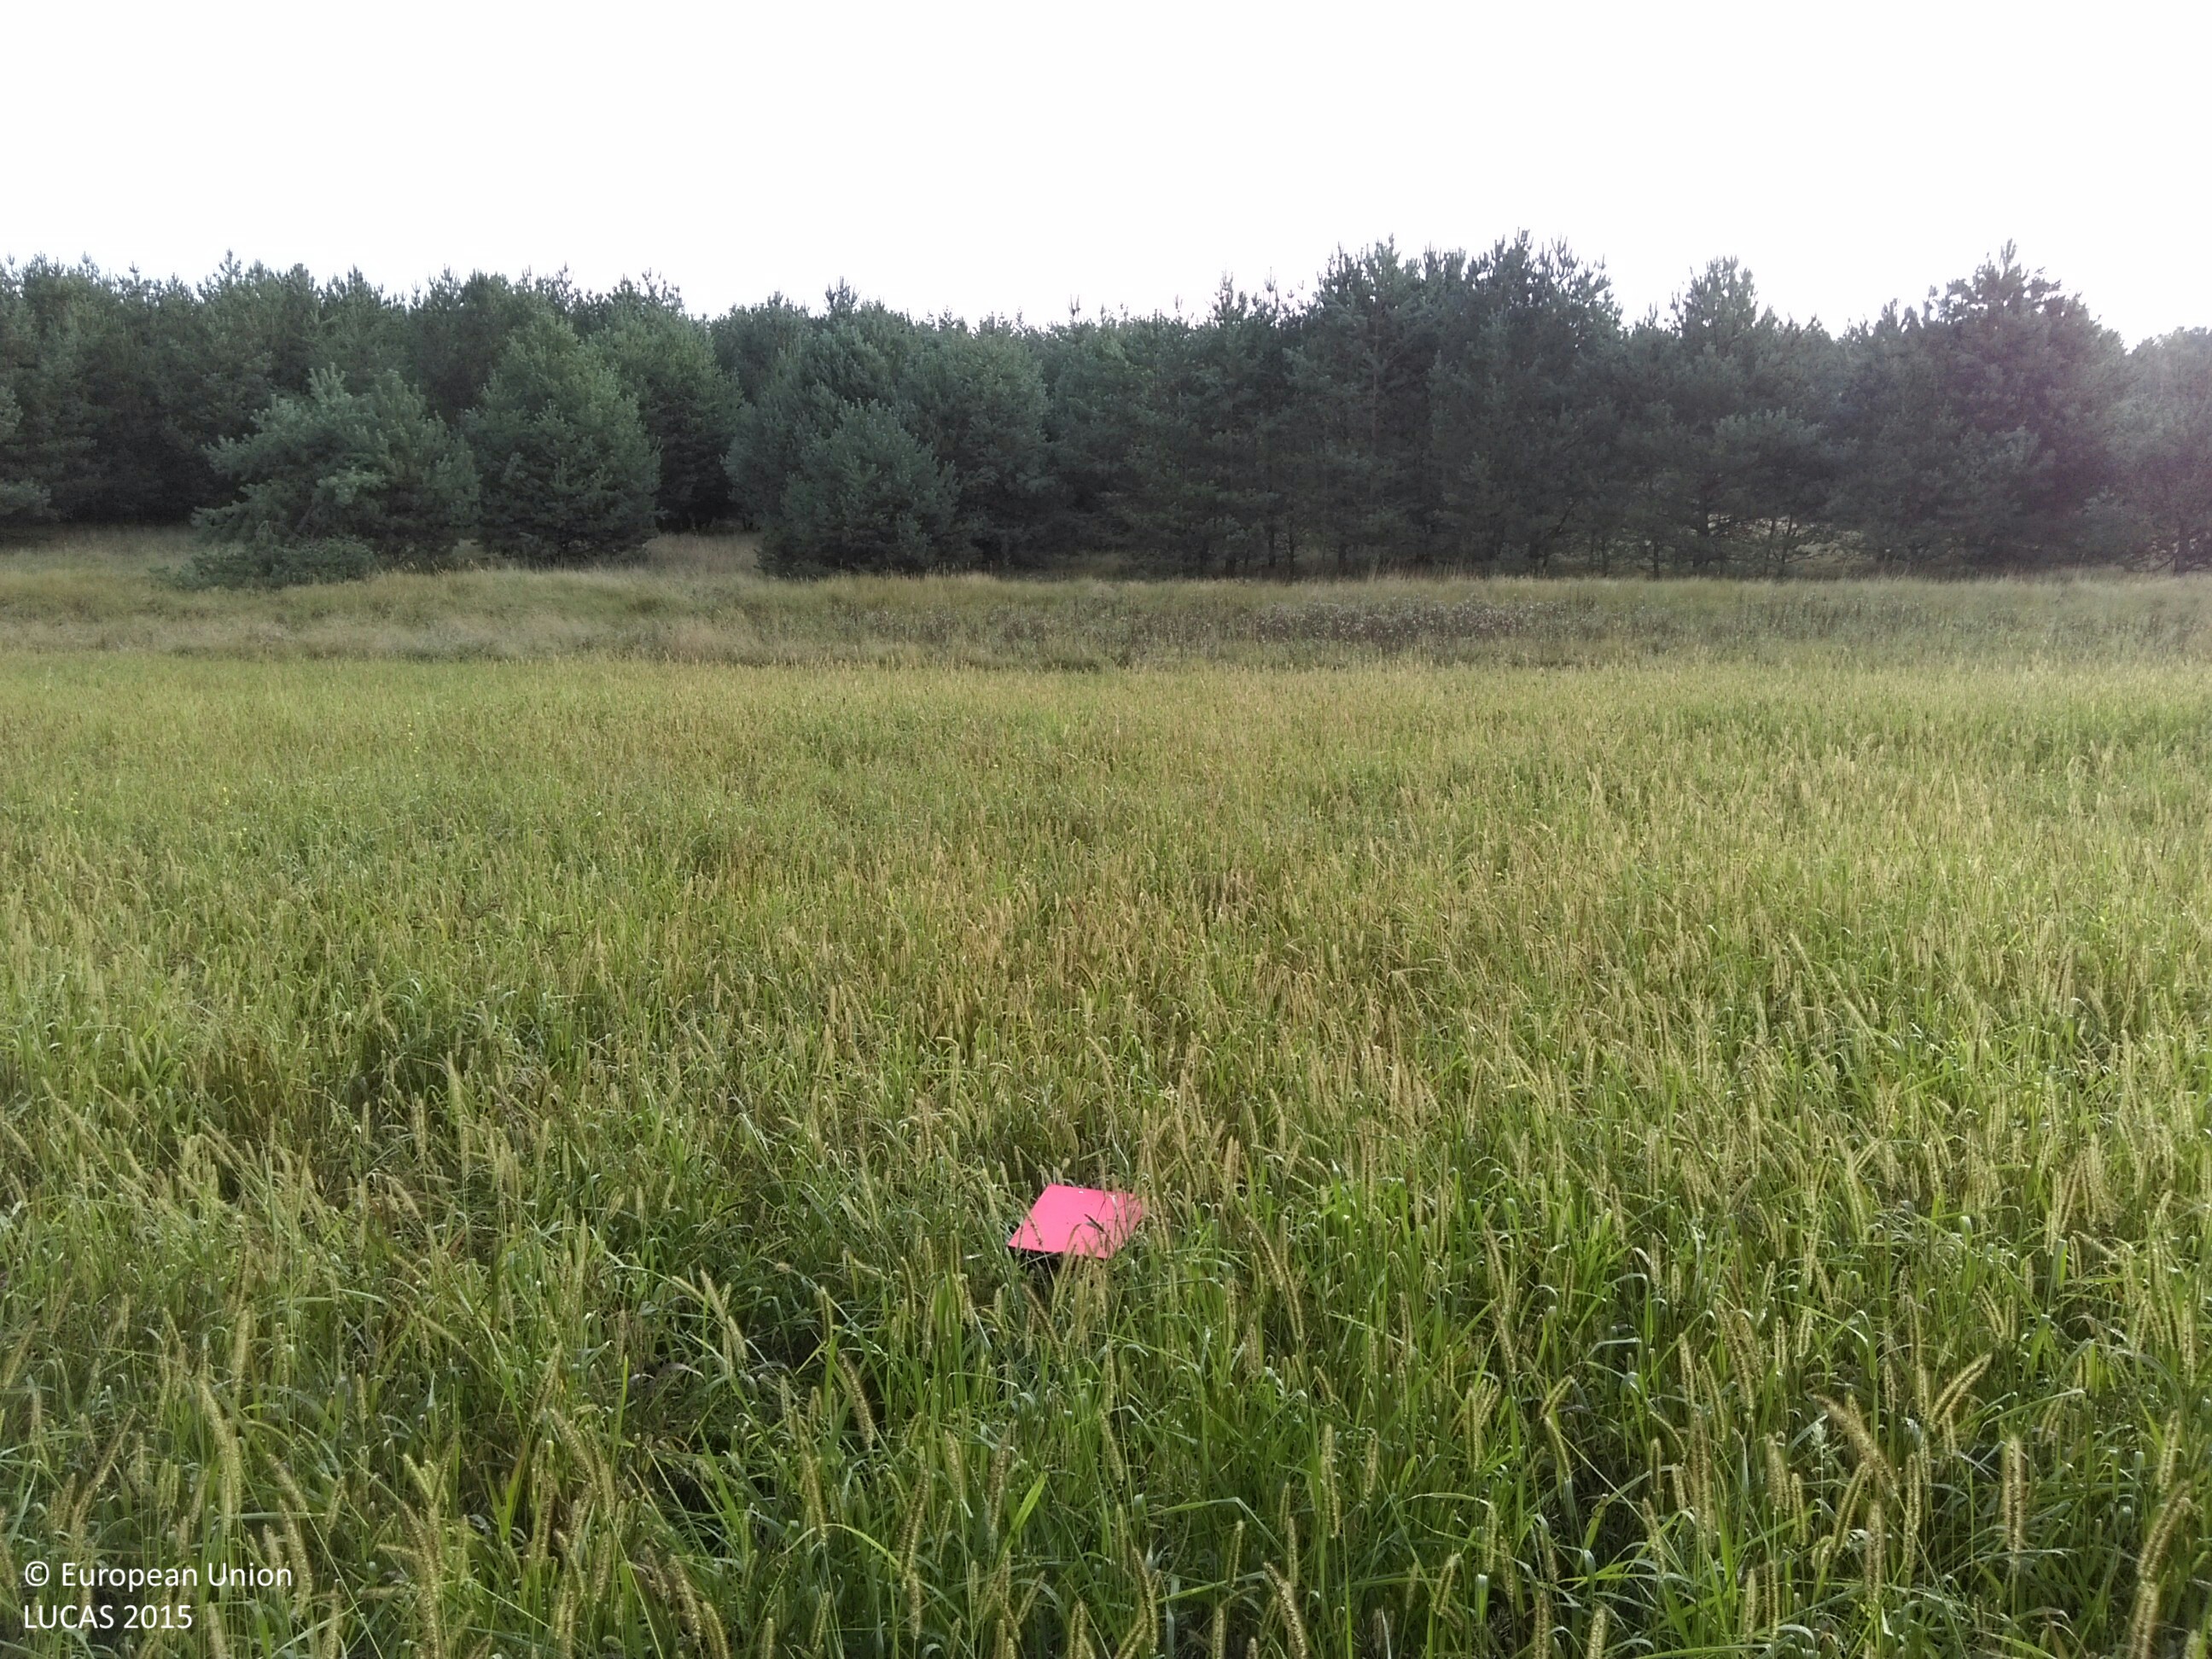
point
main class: Grassland
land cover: Grassland without tree/shrub cover
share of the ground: > 75 %
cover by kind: herbaceous plants 100 %
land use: Agriculture (excluding fallow land and kitchen gardens)
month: September
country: PL
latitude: 51.7320
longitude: 15.7823
